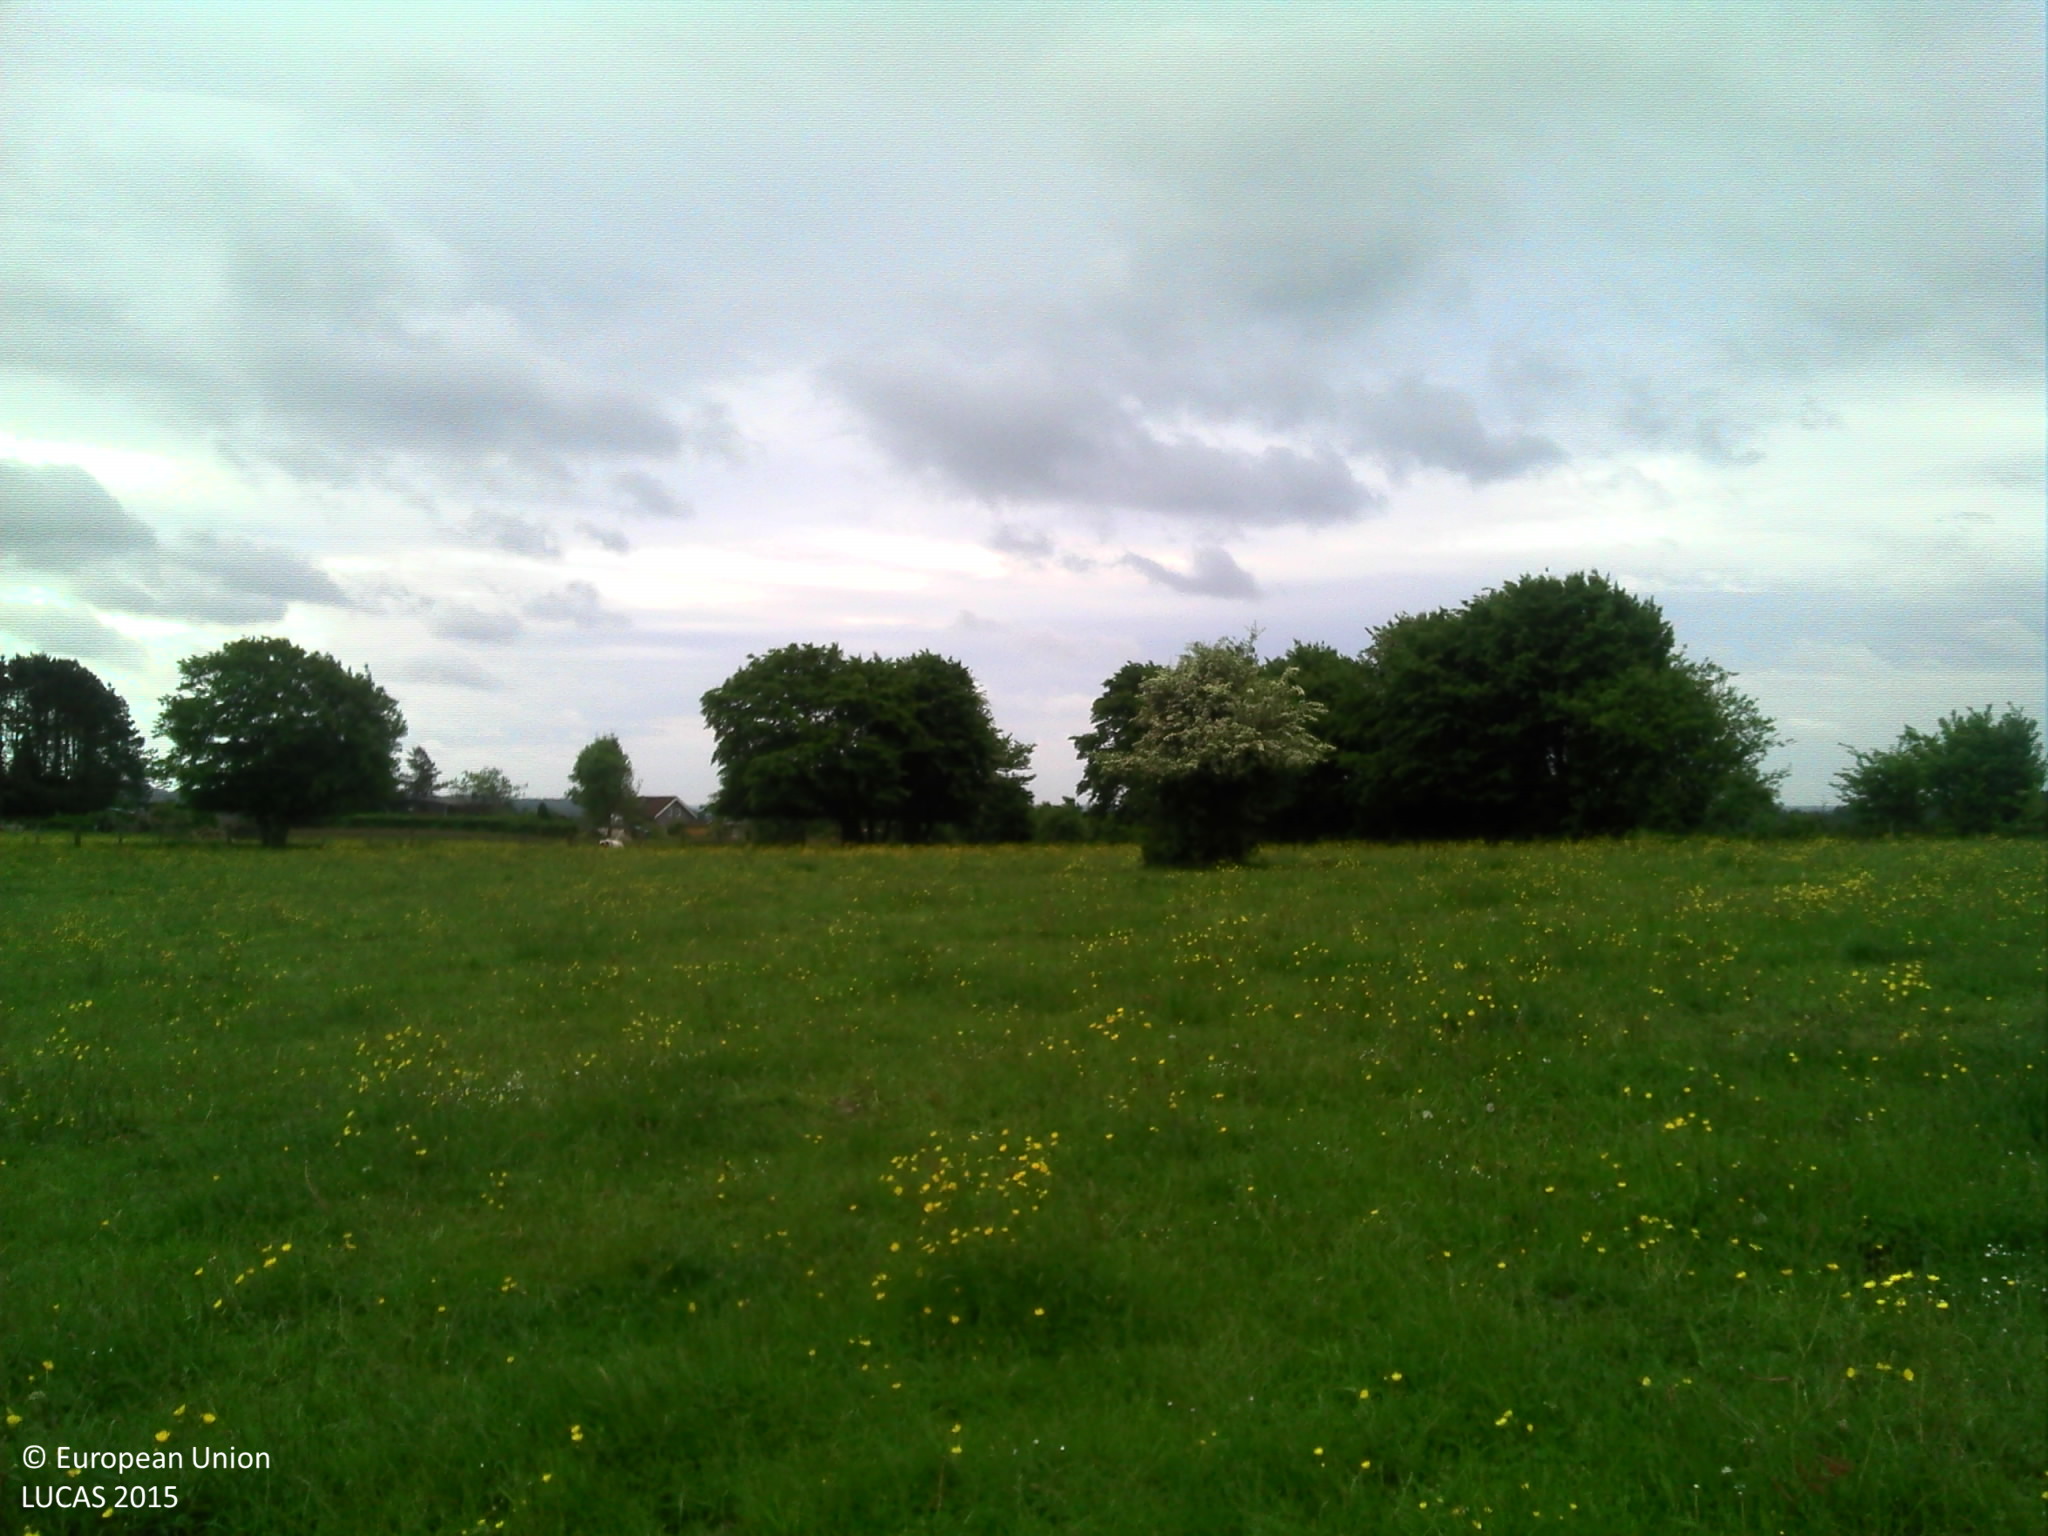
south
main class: Grassland
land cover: Grassland without tree/shrub cover
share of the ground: > 75 %
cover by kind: herbaceous plants 100 %
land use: Agriculture (excluding fallow land and kitchen gardens)
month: June
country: BE
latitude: 49.9087
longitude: 4.9146
